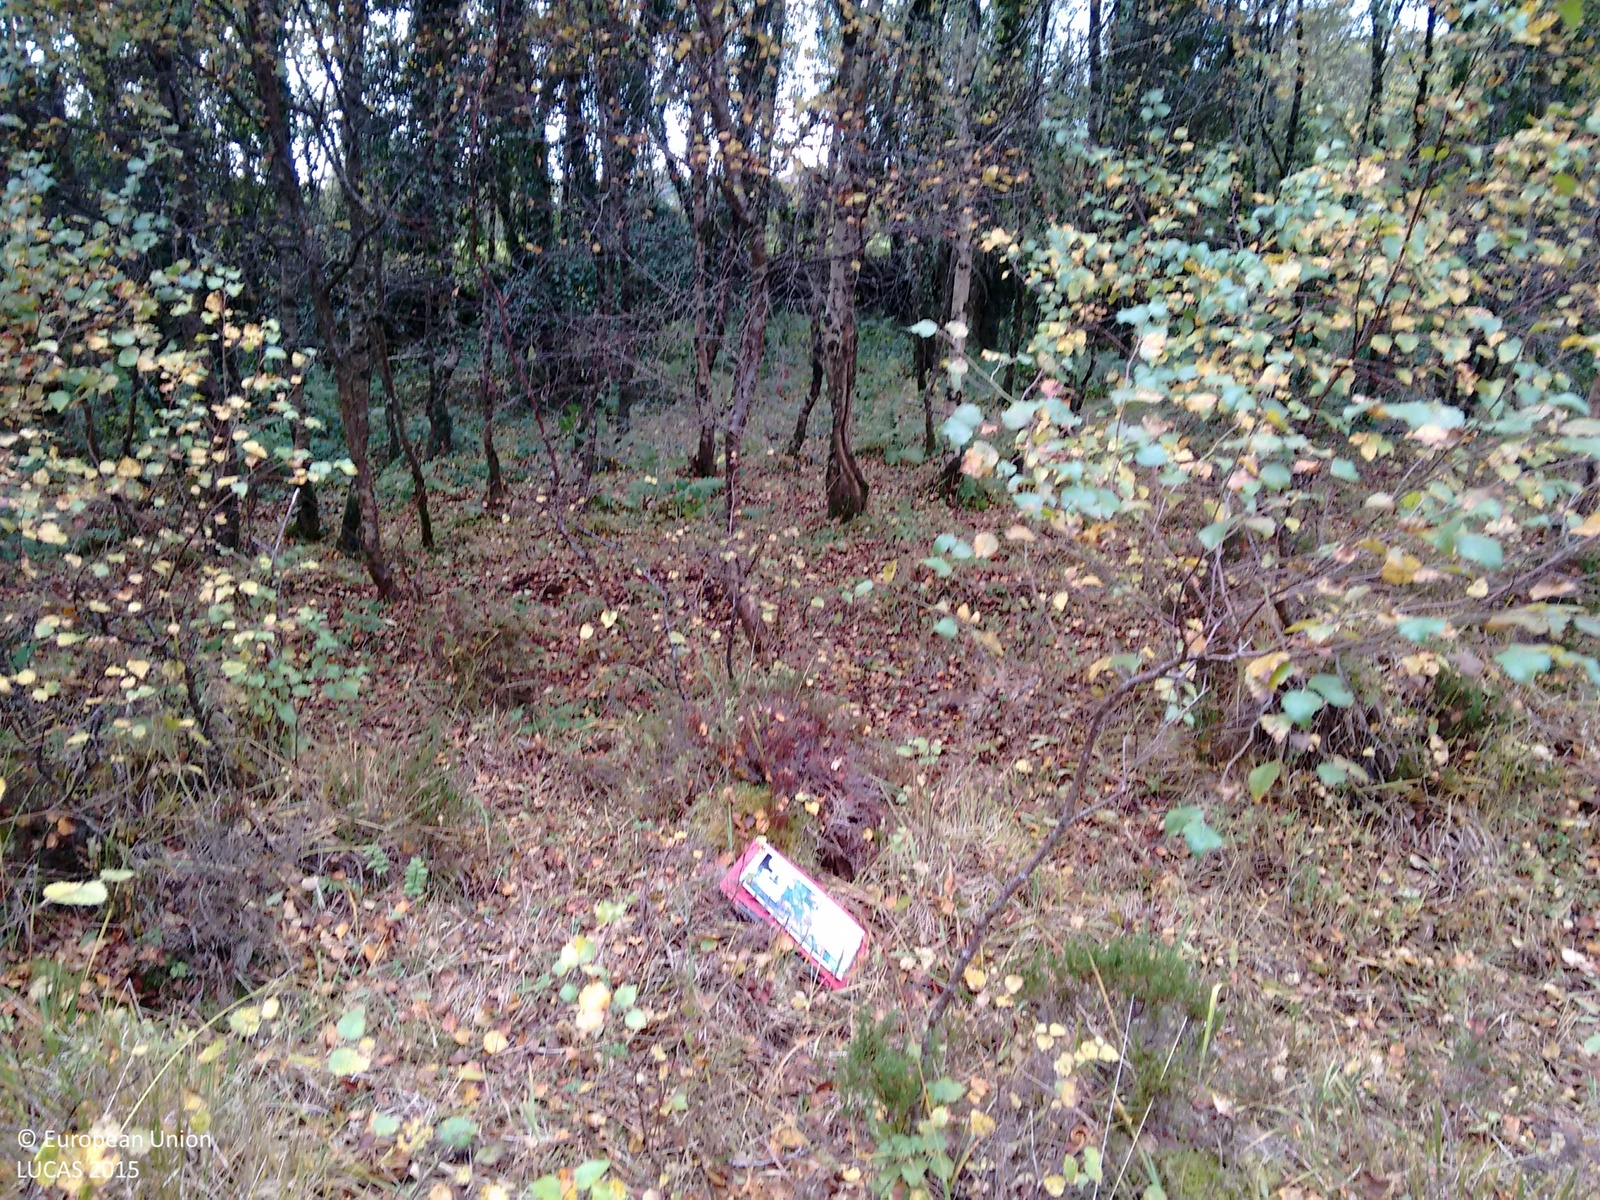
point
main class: Woodland
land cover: Broadleaved woodland
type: acidophilous oak and oak-birch forest
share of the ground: > 75 %
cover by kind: broadleaved forest trees 100 %
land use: Semi-natural and natural areas not in use
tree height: > 5 m
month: October
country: GB
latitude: 54.3571
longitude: -7.4026
